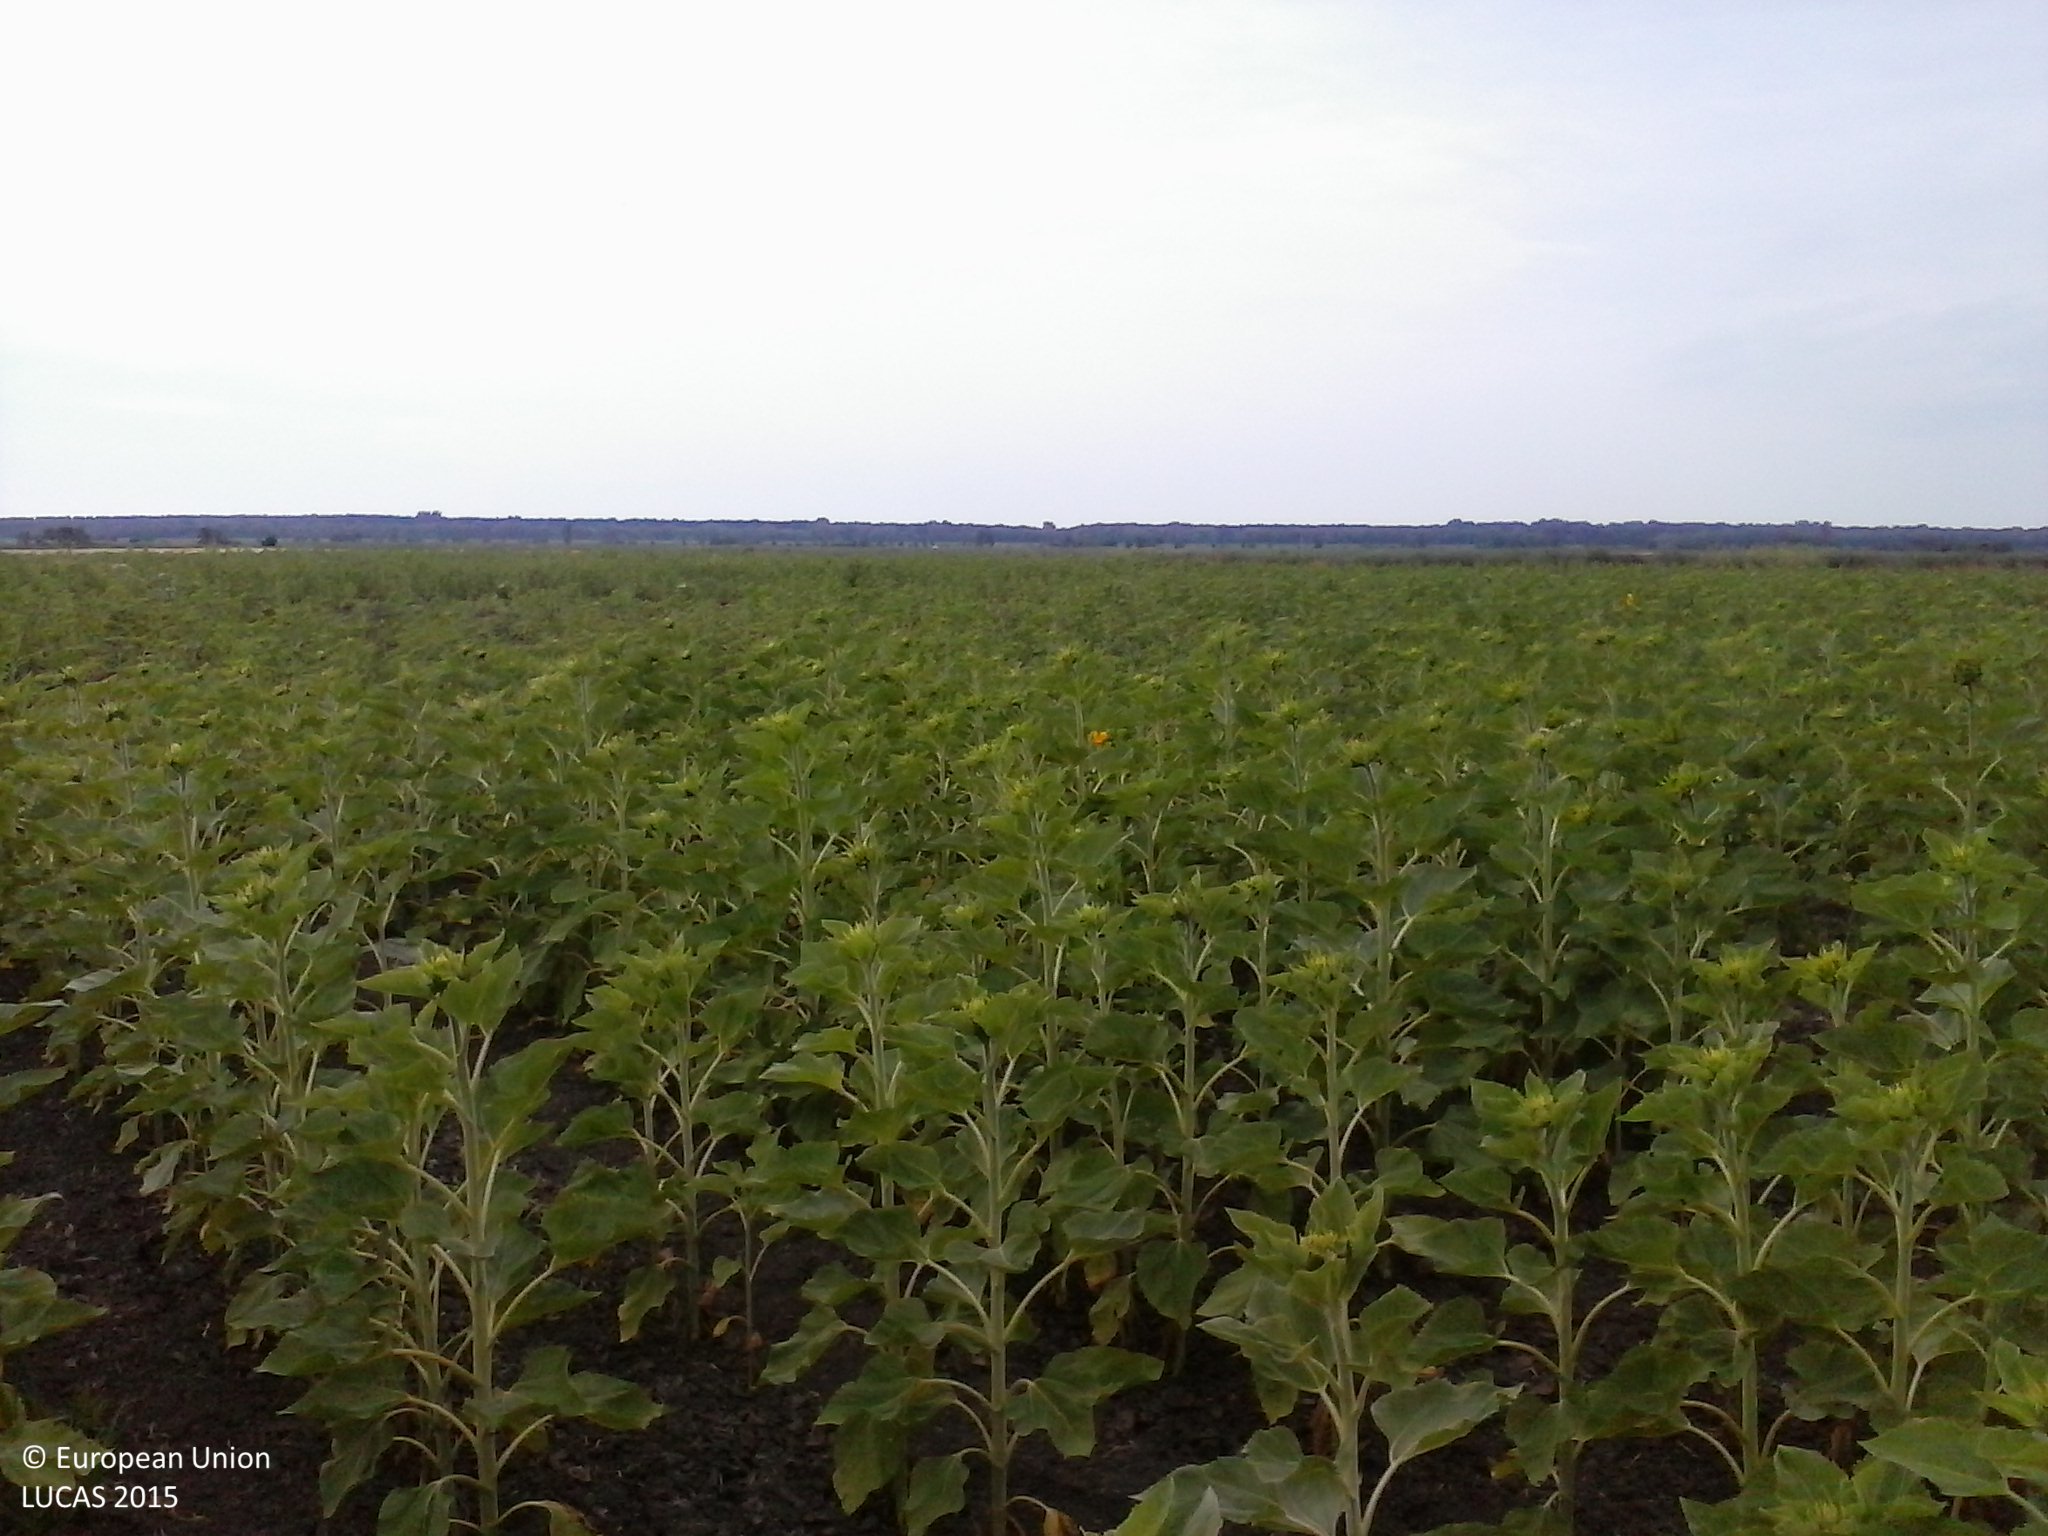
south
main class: Cropland
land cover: Sunflower
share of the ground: > 75 %
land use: Agriculture (excluding fallow land and kitchen gardens)
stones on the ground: < 10 %
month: June
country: HU
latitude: 46.2689
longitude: 20.3131
